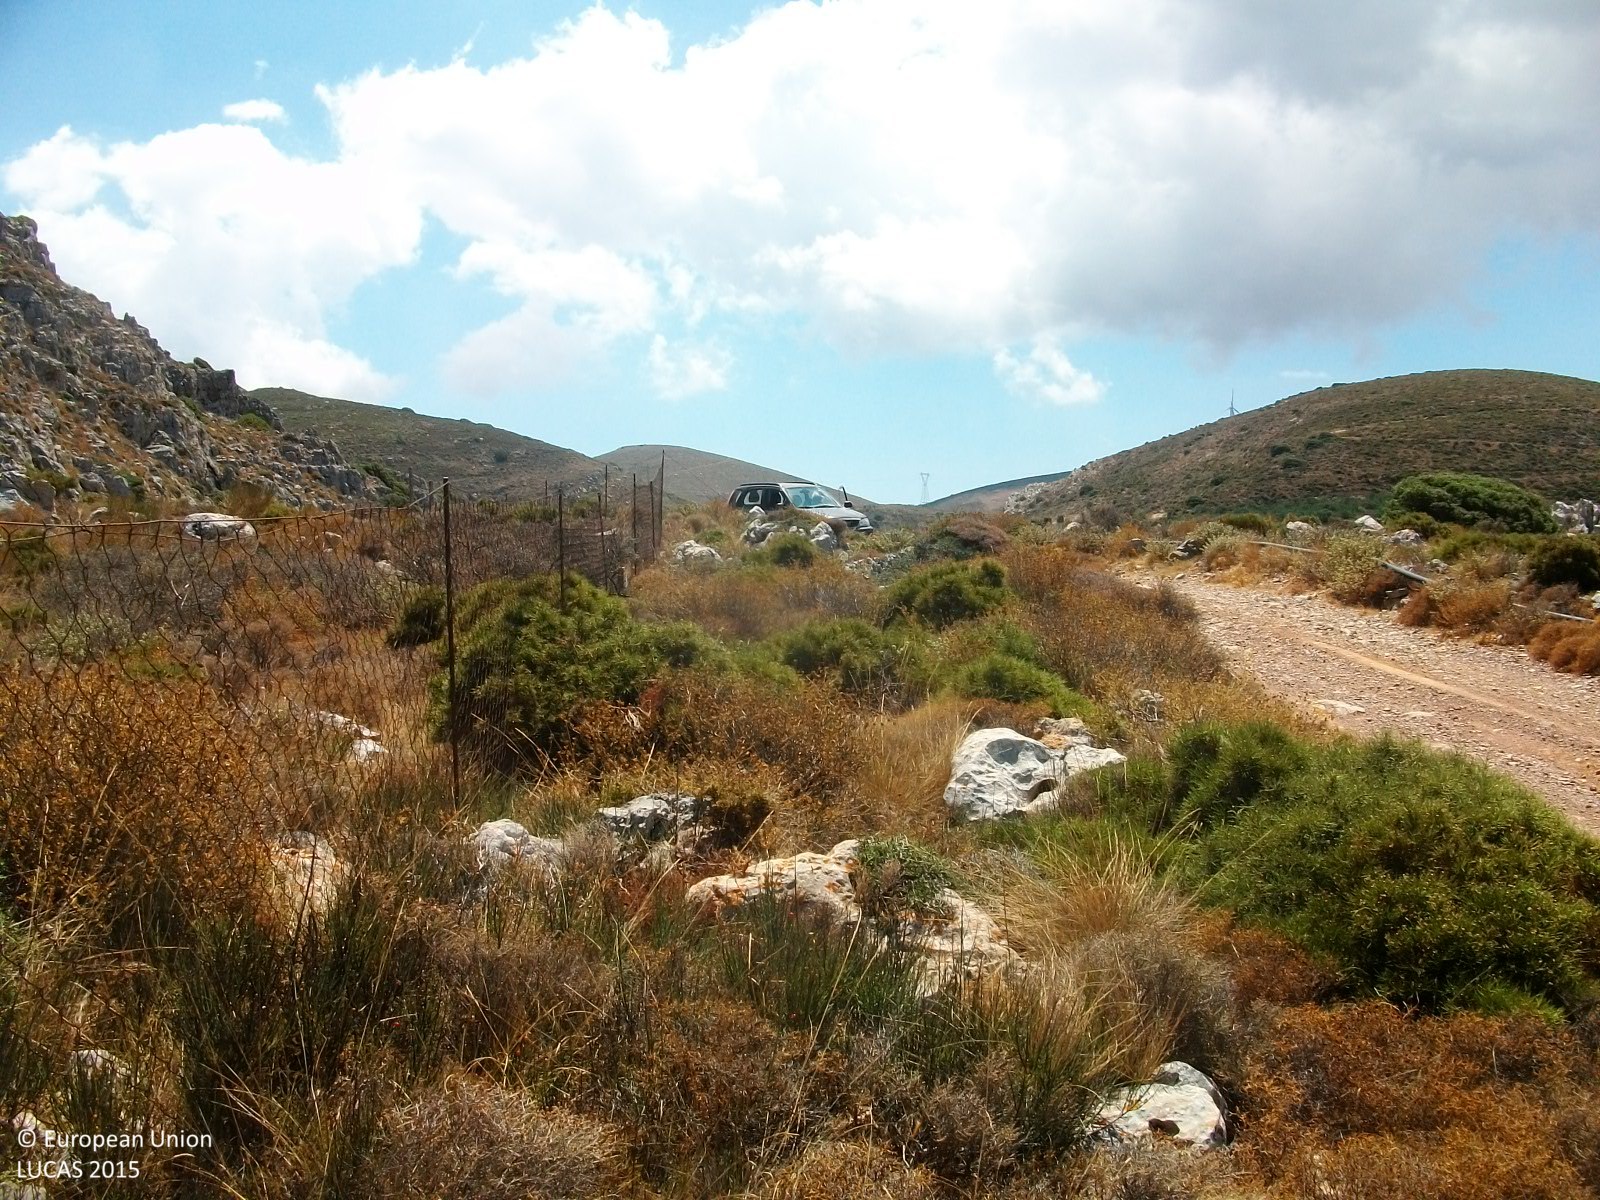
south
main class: Shrubland
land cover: Shrubland without tree cover
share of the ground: 50 - 75 %
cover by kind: shrubs 60 %, unconsolidated bare surface 40 %
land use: Semi-natural and natural areas not in use
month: August
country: GR
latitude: 35.1074
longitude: 26.1172
